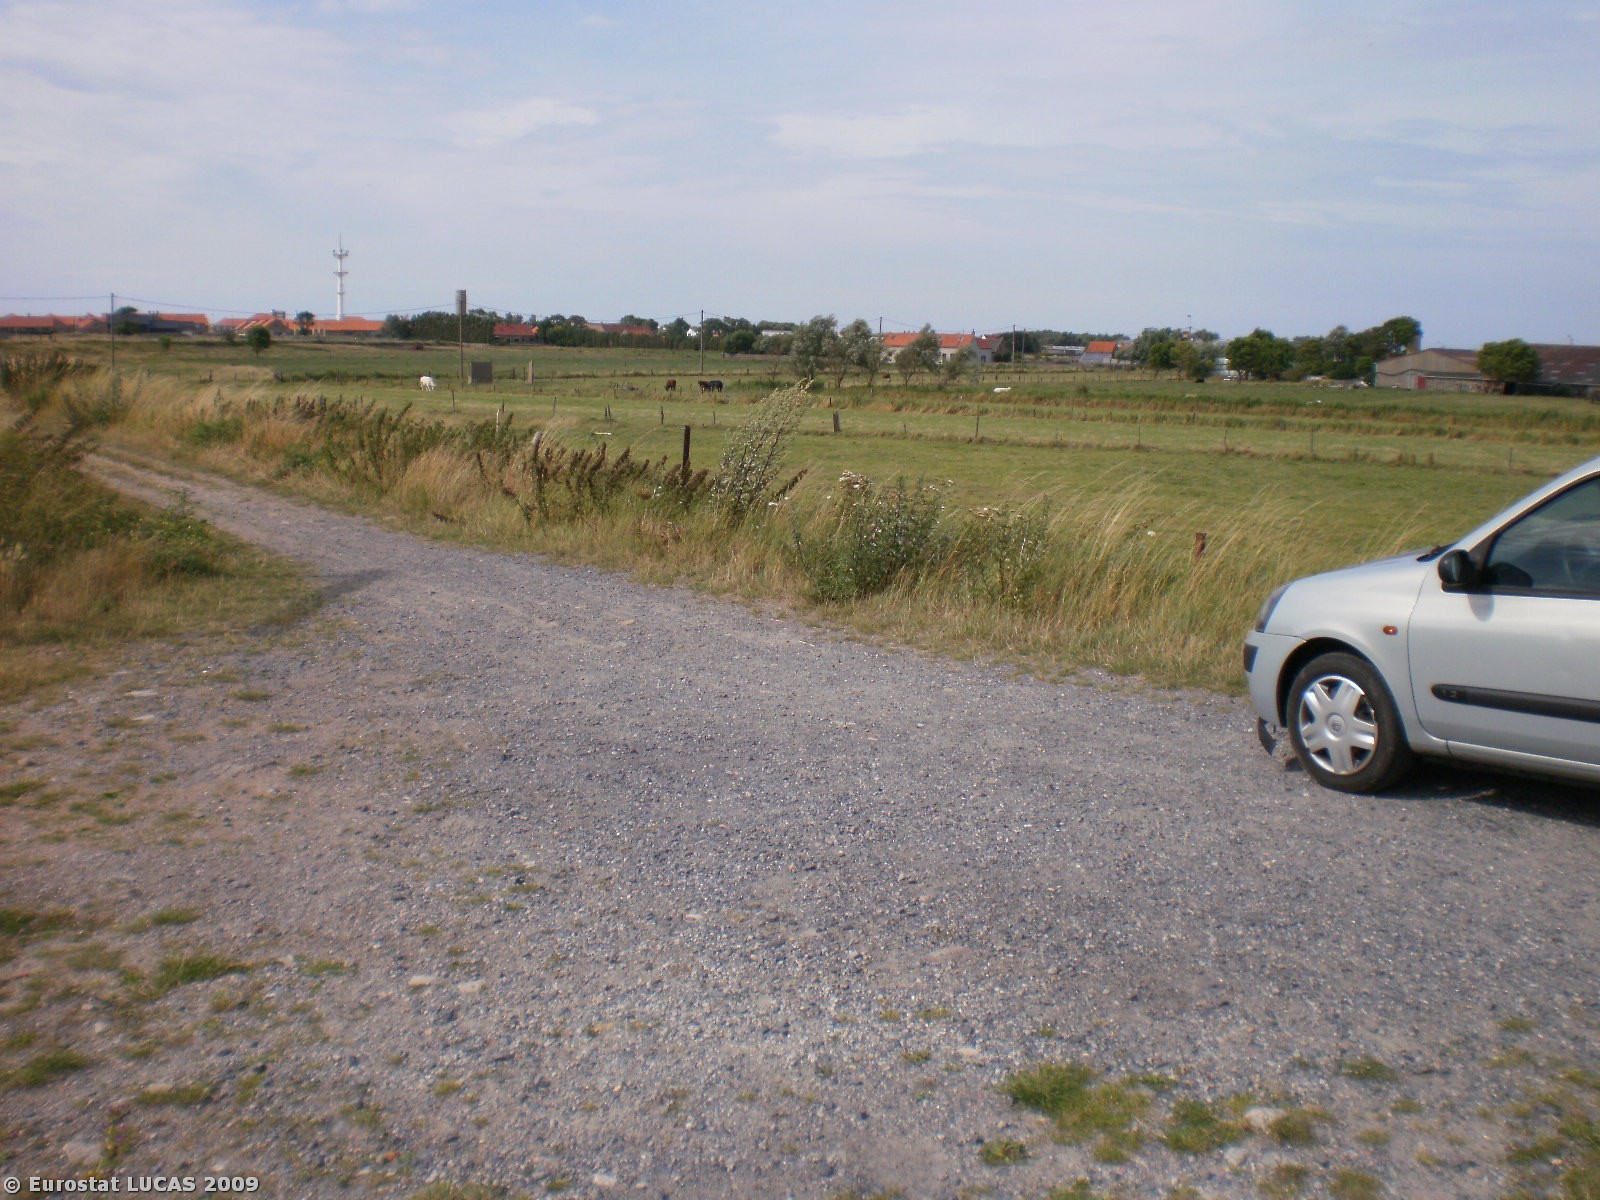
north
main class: Wetlands
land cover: Intertidal flats
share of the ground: > 75 %
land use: Nature reserves
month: July
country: BE
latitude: 51.1443
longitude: 2.7414
